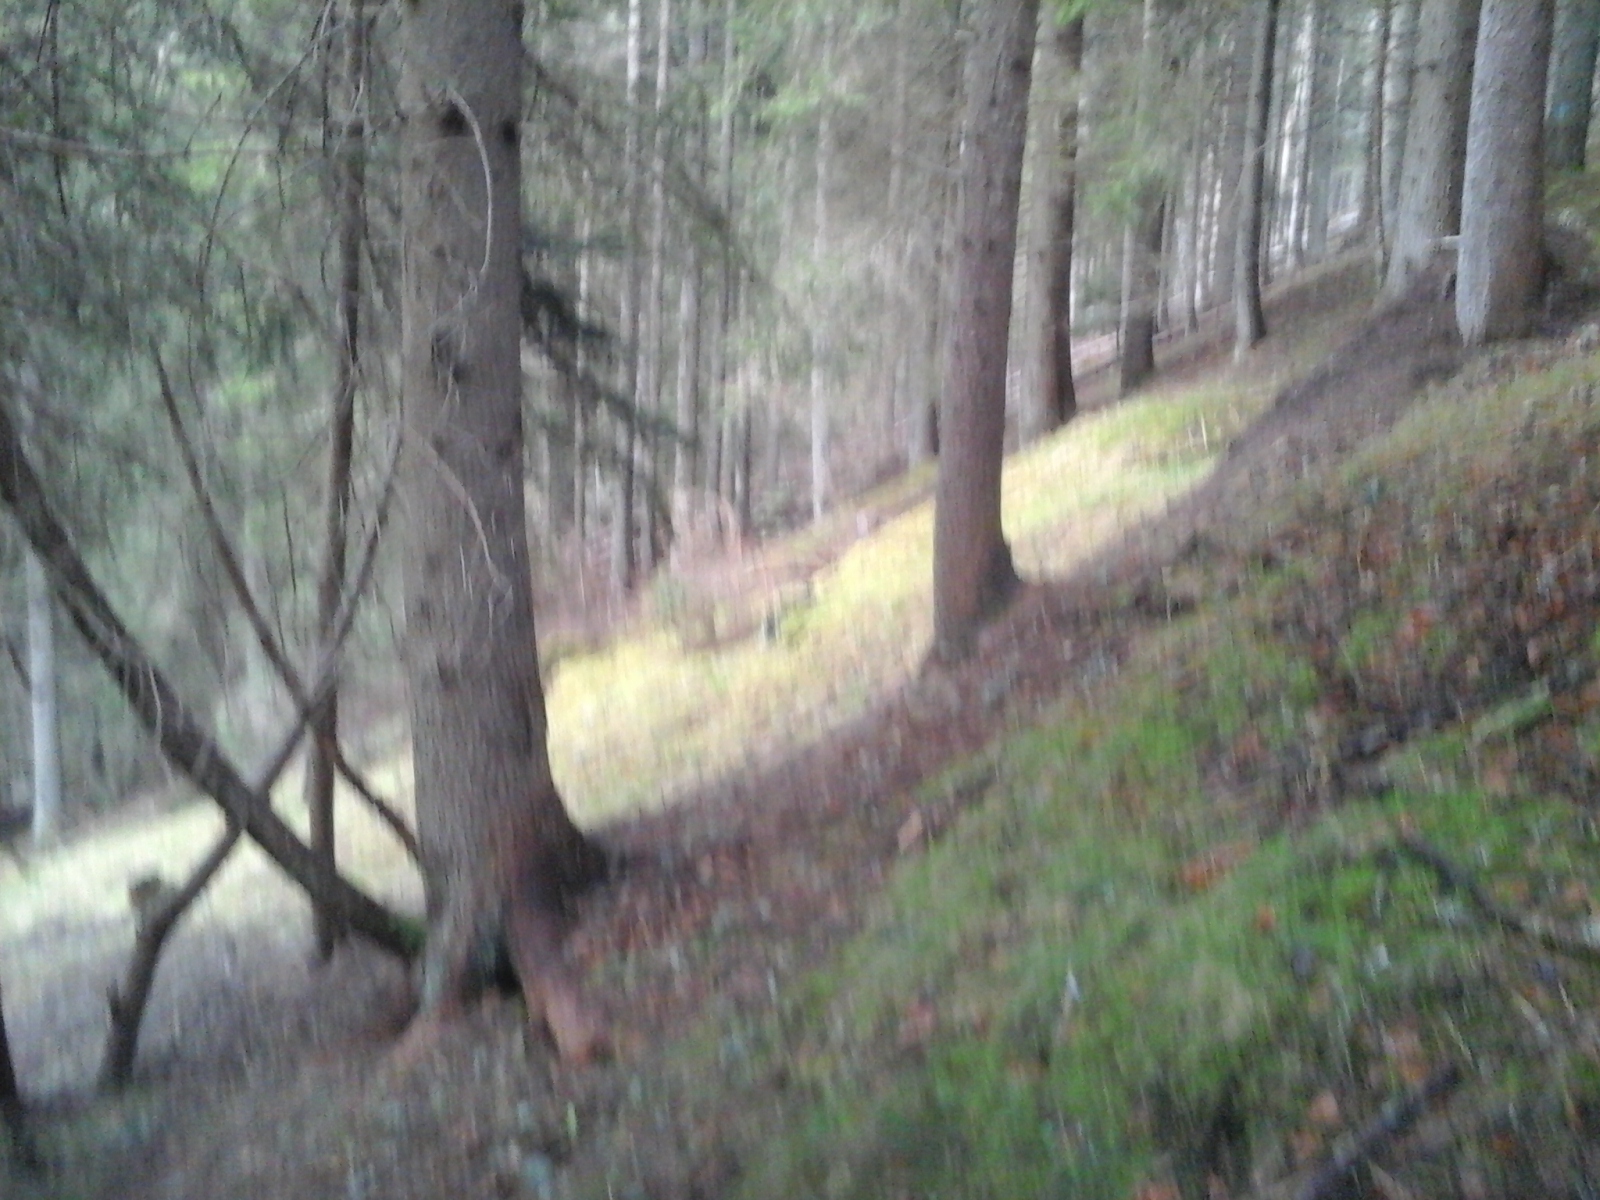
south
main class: Woodland
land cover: Spruce dominated coniferous woodland
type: alpine coniferous forest
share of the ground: > 75 %
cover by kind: coniferous forest trees 95 %, lichens and mosses 5 %
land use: Forestry
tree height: > 5 m
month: May
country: IT
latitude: 46.3807
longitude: 11.1816
